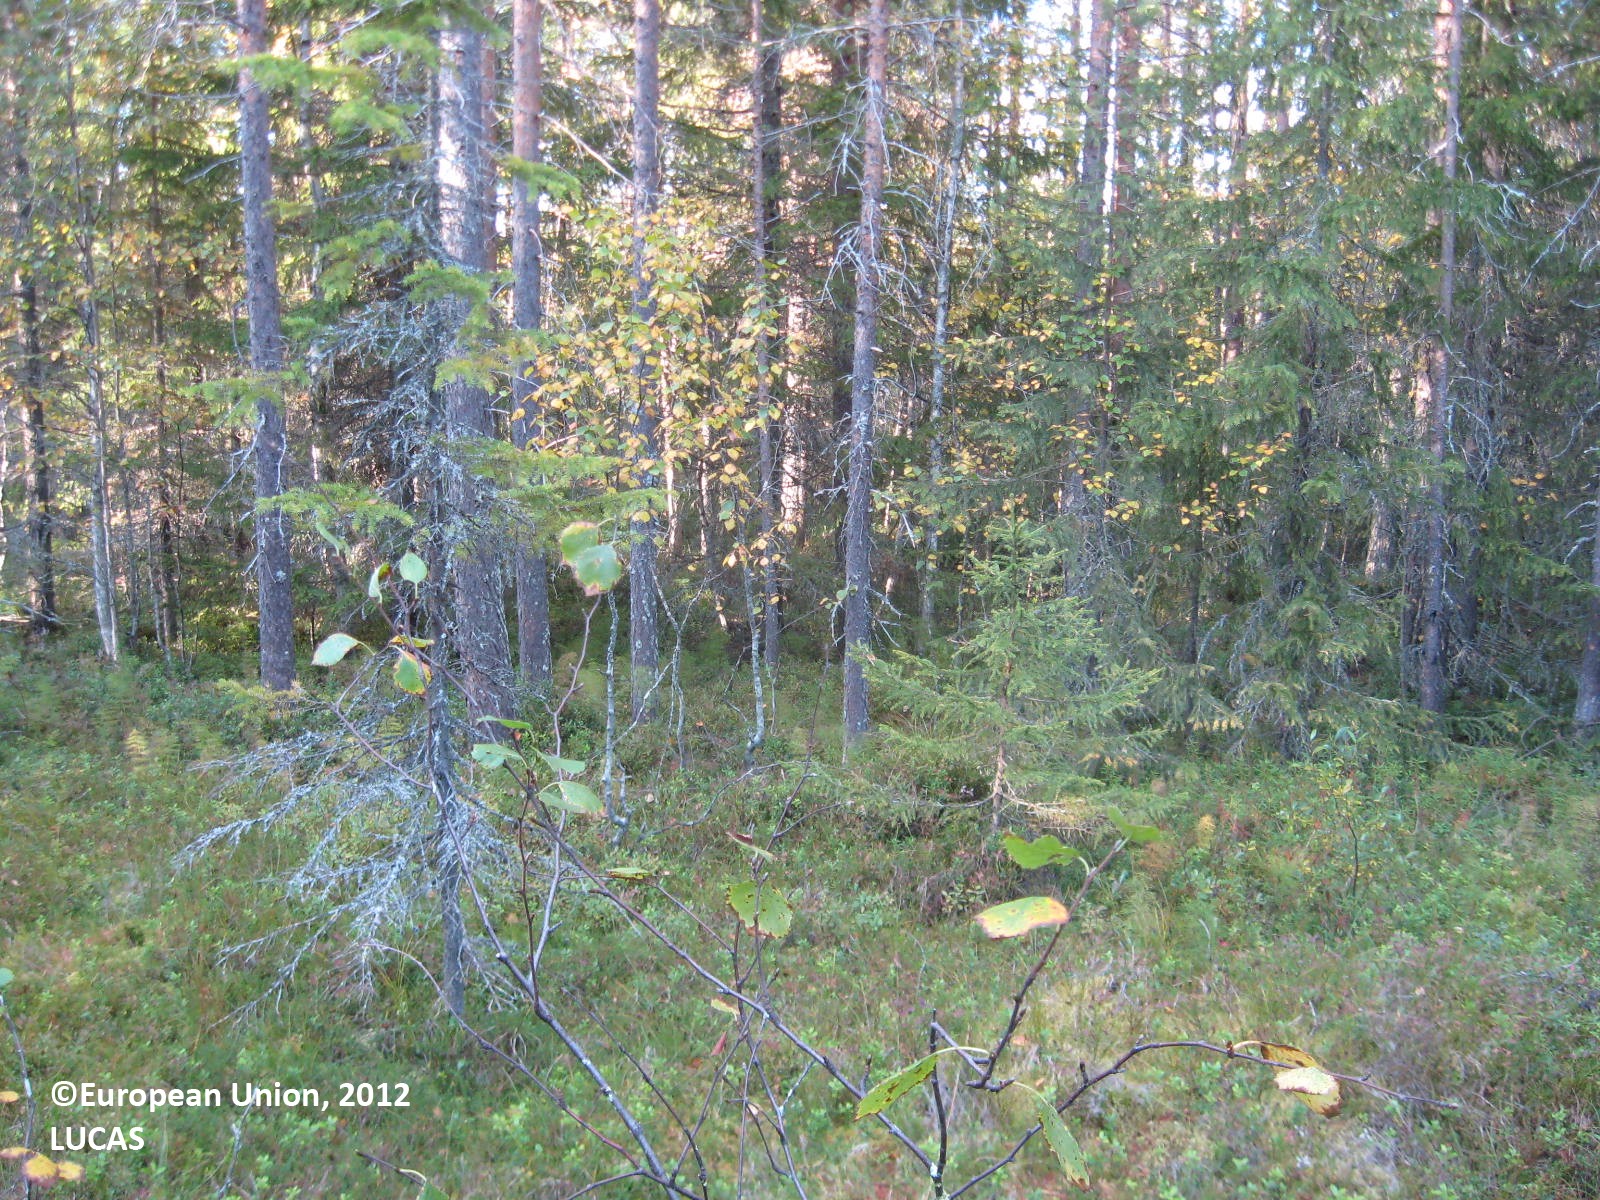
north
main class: Woodland
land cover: Pine dominated coniferous woodland
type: boreal forest
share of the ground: > 75 %
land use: Forestry
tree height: > 5 m
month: August
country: FI
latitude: 63.9506
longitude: 29.6790
